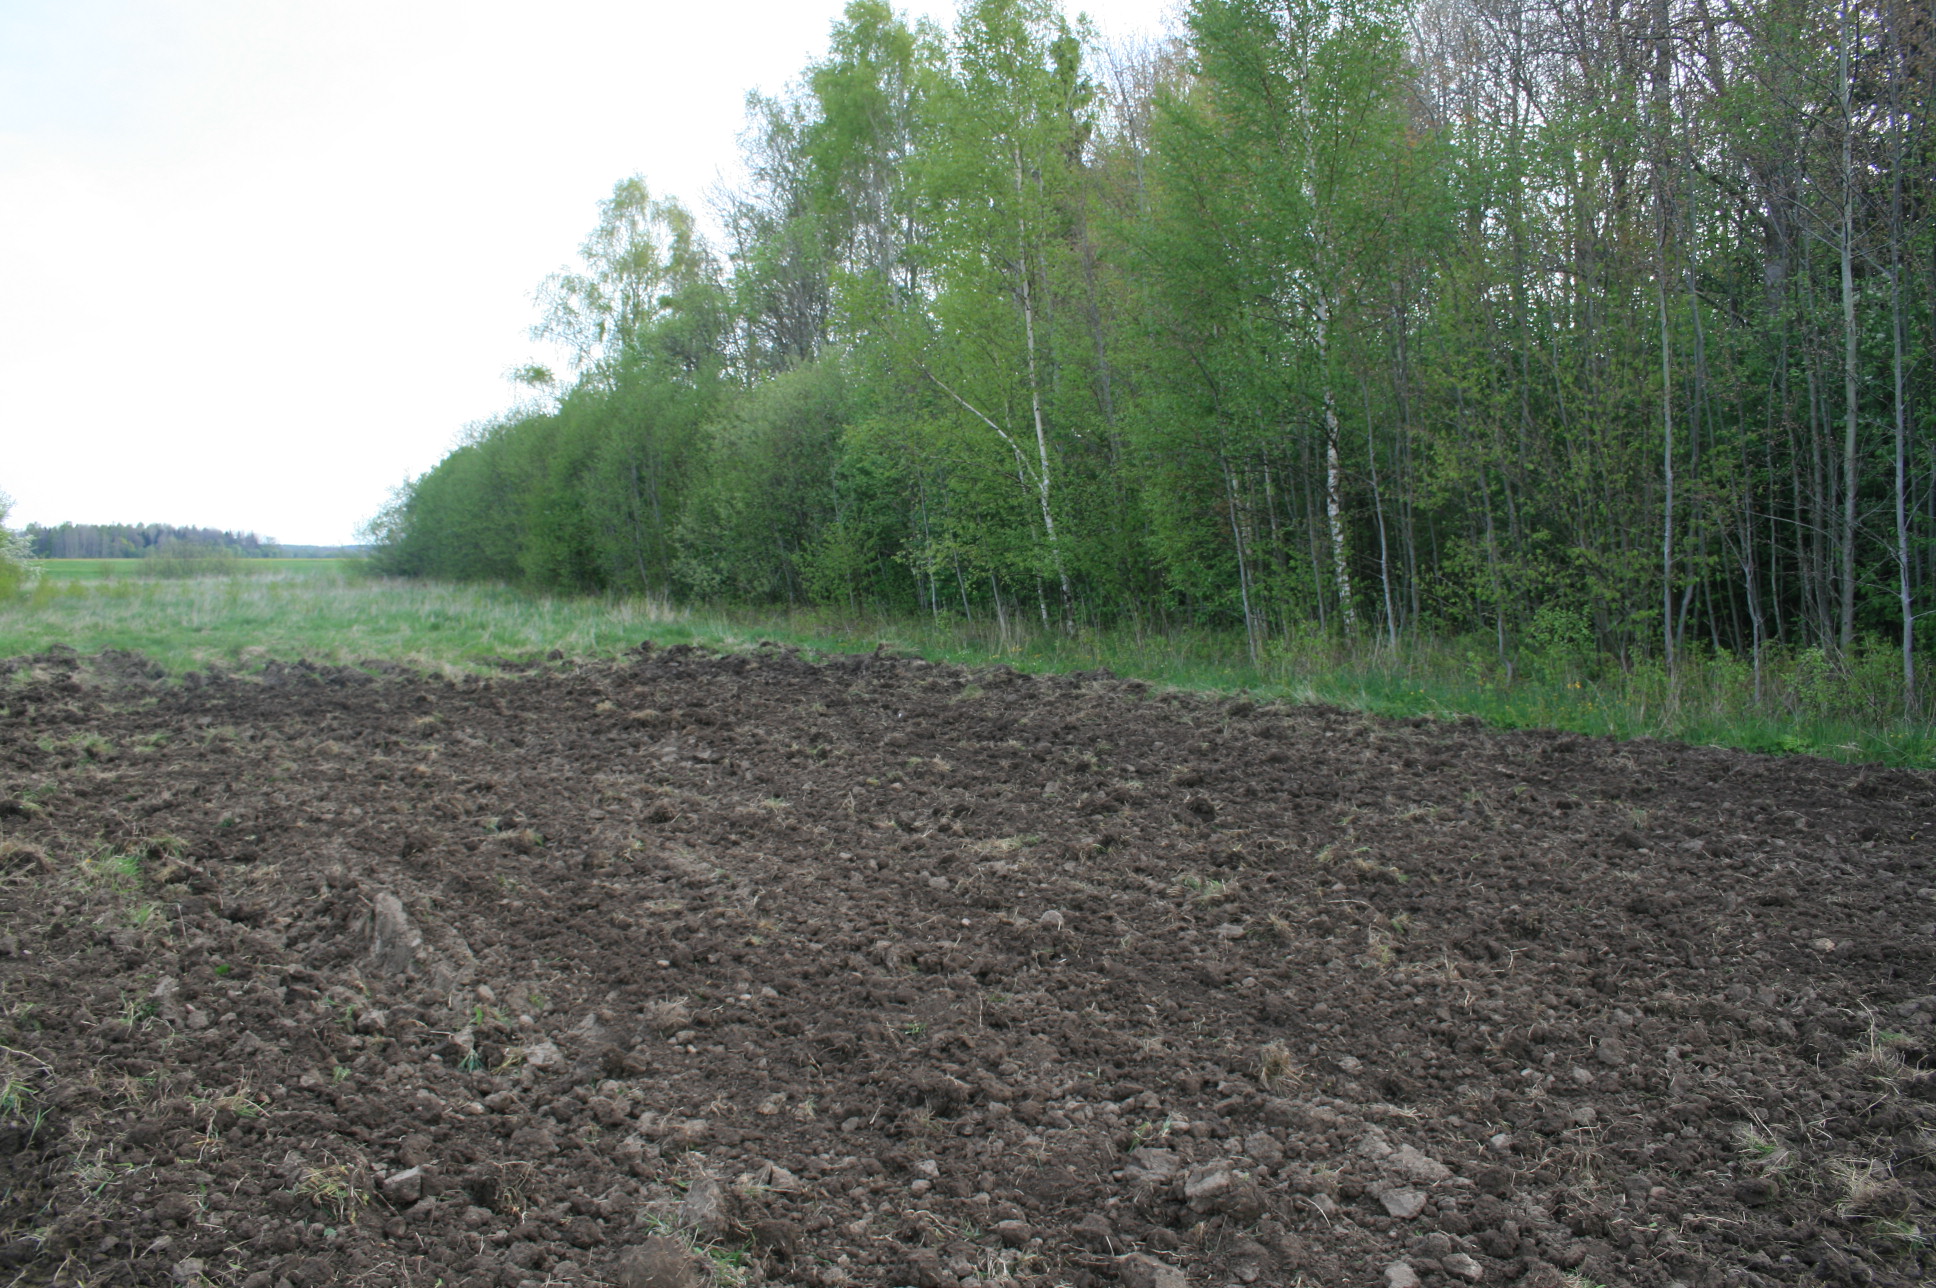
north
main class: Cropland
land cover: Durum wheat
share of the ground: > 75 %
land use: Agriculture (excluding fallow land and kitchen gardens)
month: May
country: LT
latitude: 56.2403
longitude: 21.6137
